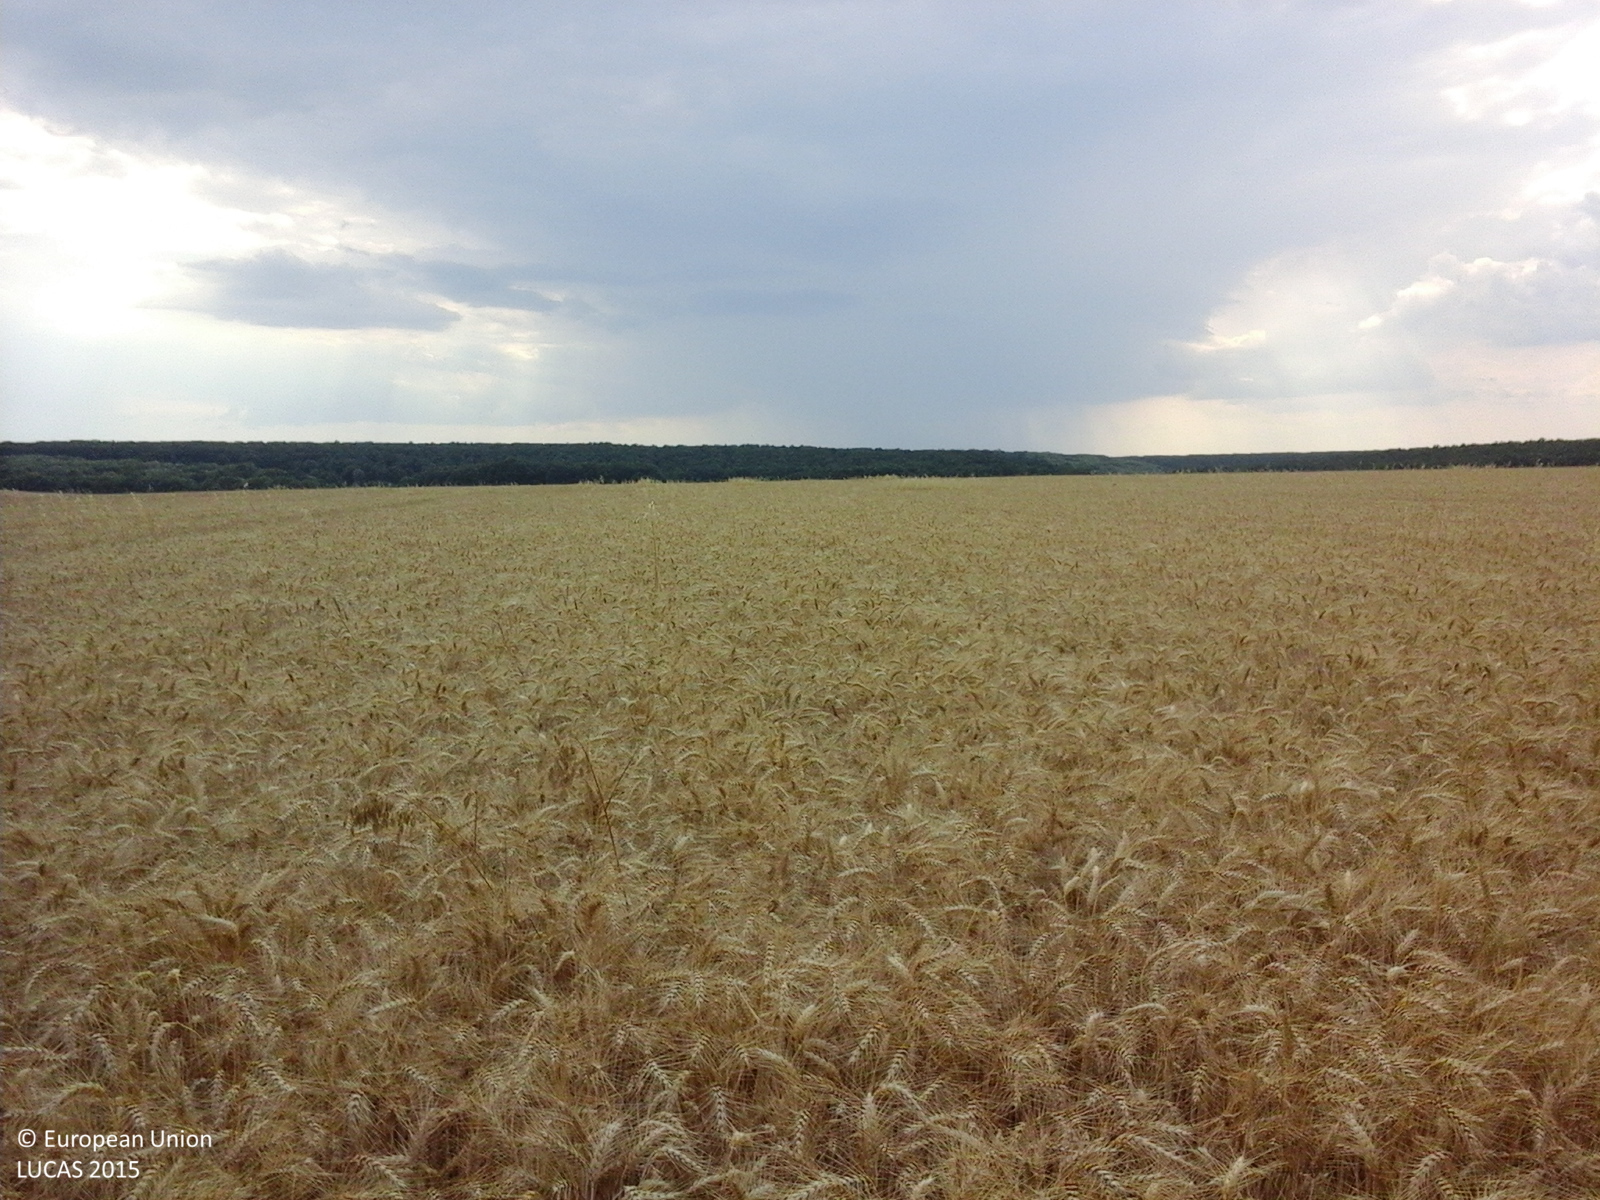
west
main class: Cropland
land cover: Common wheat
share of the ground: > 75 %
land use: Agriculture (excluding fallow land and kitchen gardens)
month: June
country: RO
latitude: 44.1693
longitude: 26.2006
